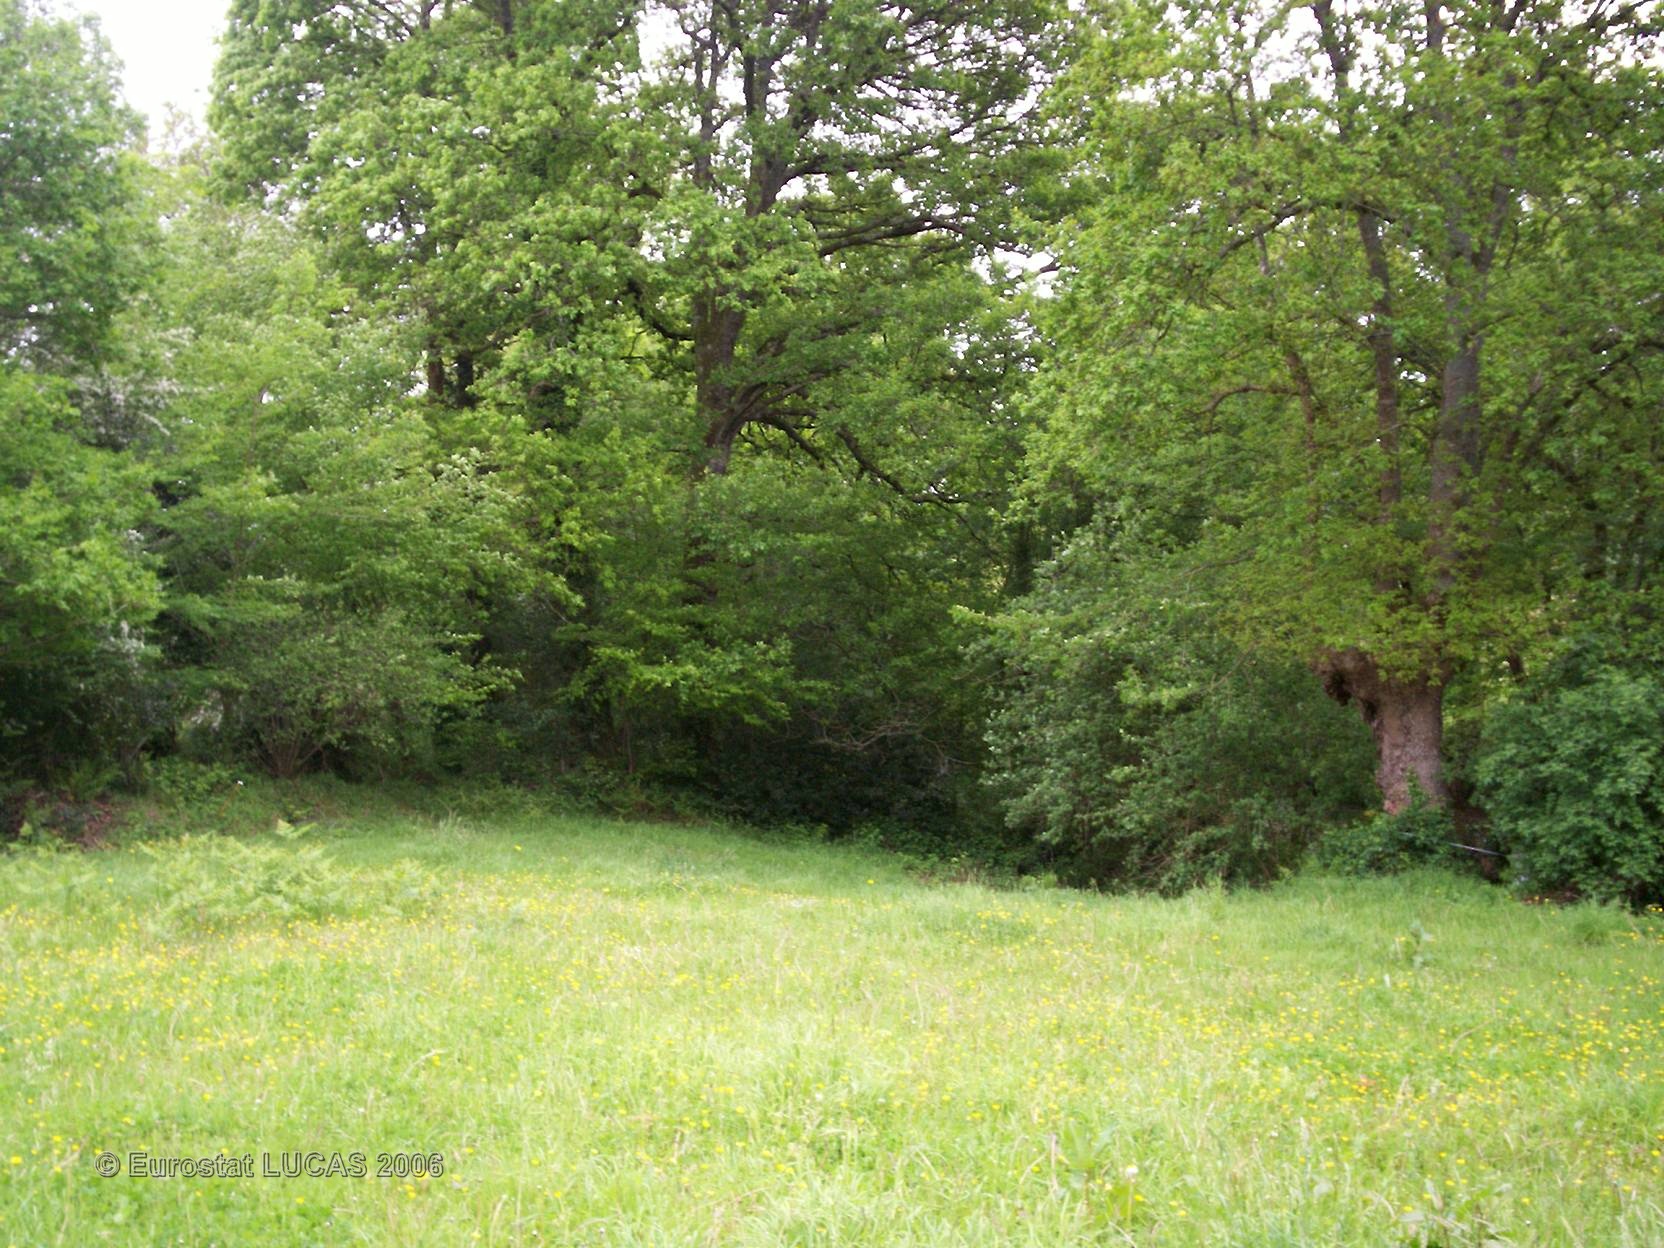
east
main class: Grassland
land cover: Grassland without tree/shrub cover
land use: Agriculture (excluding fallow land and kitchen gardens)
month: May
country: FR
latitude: 48.0686
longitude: -3.8940
